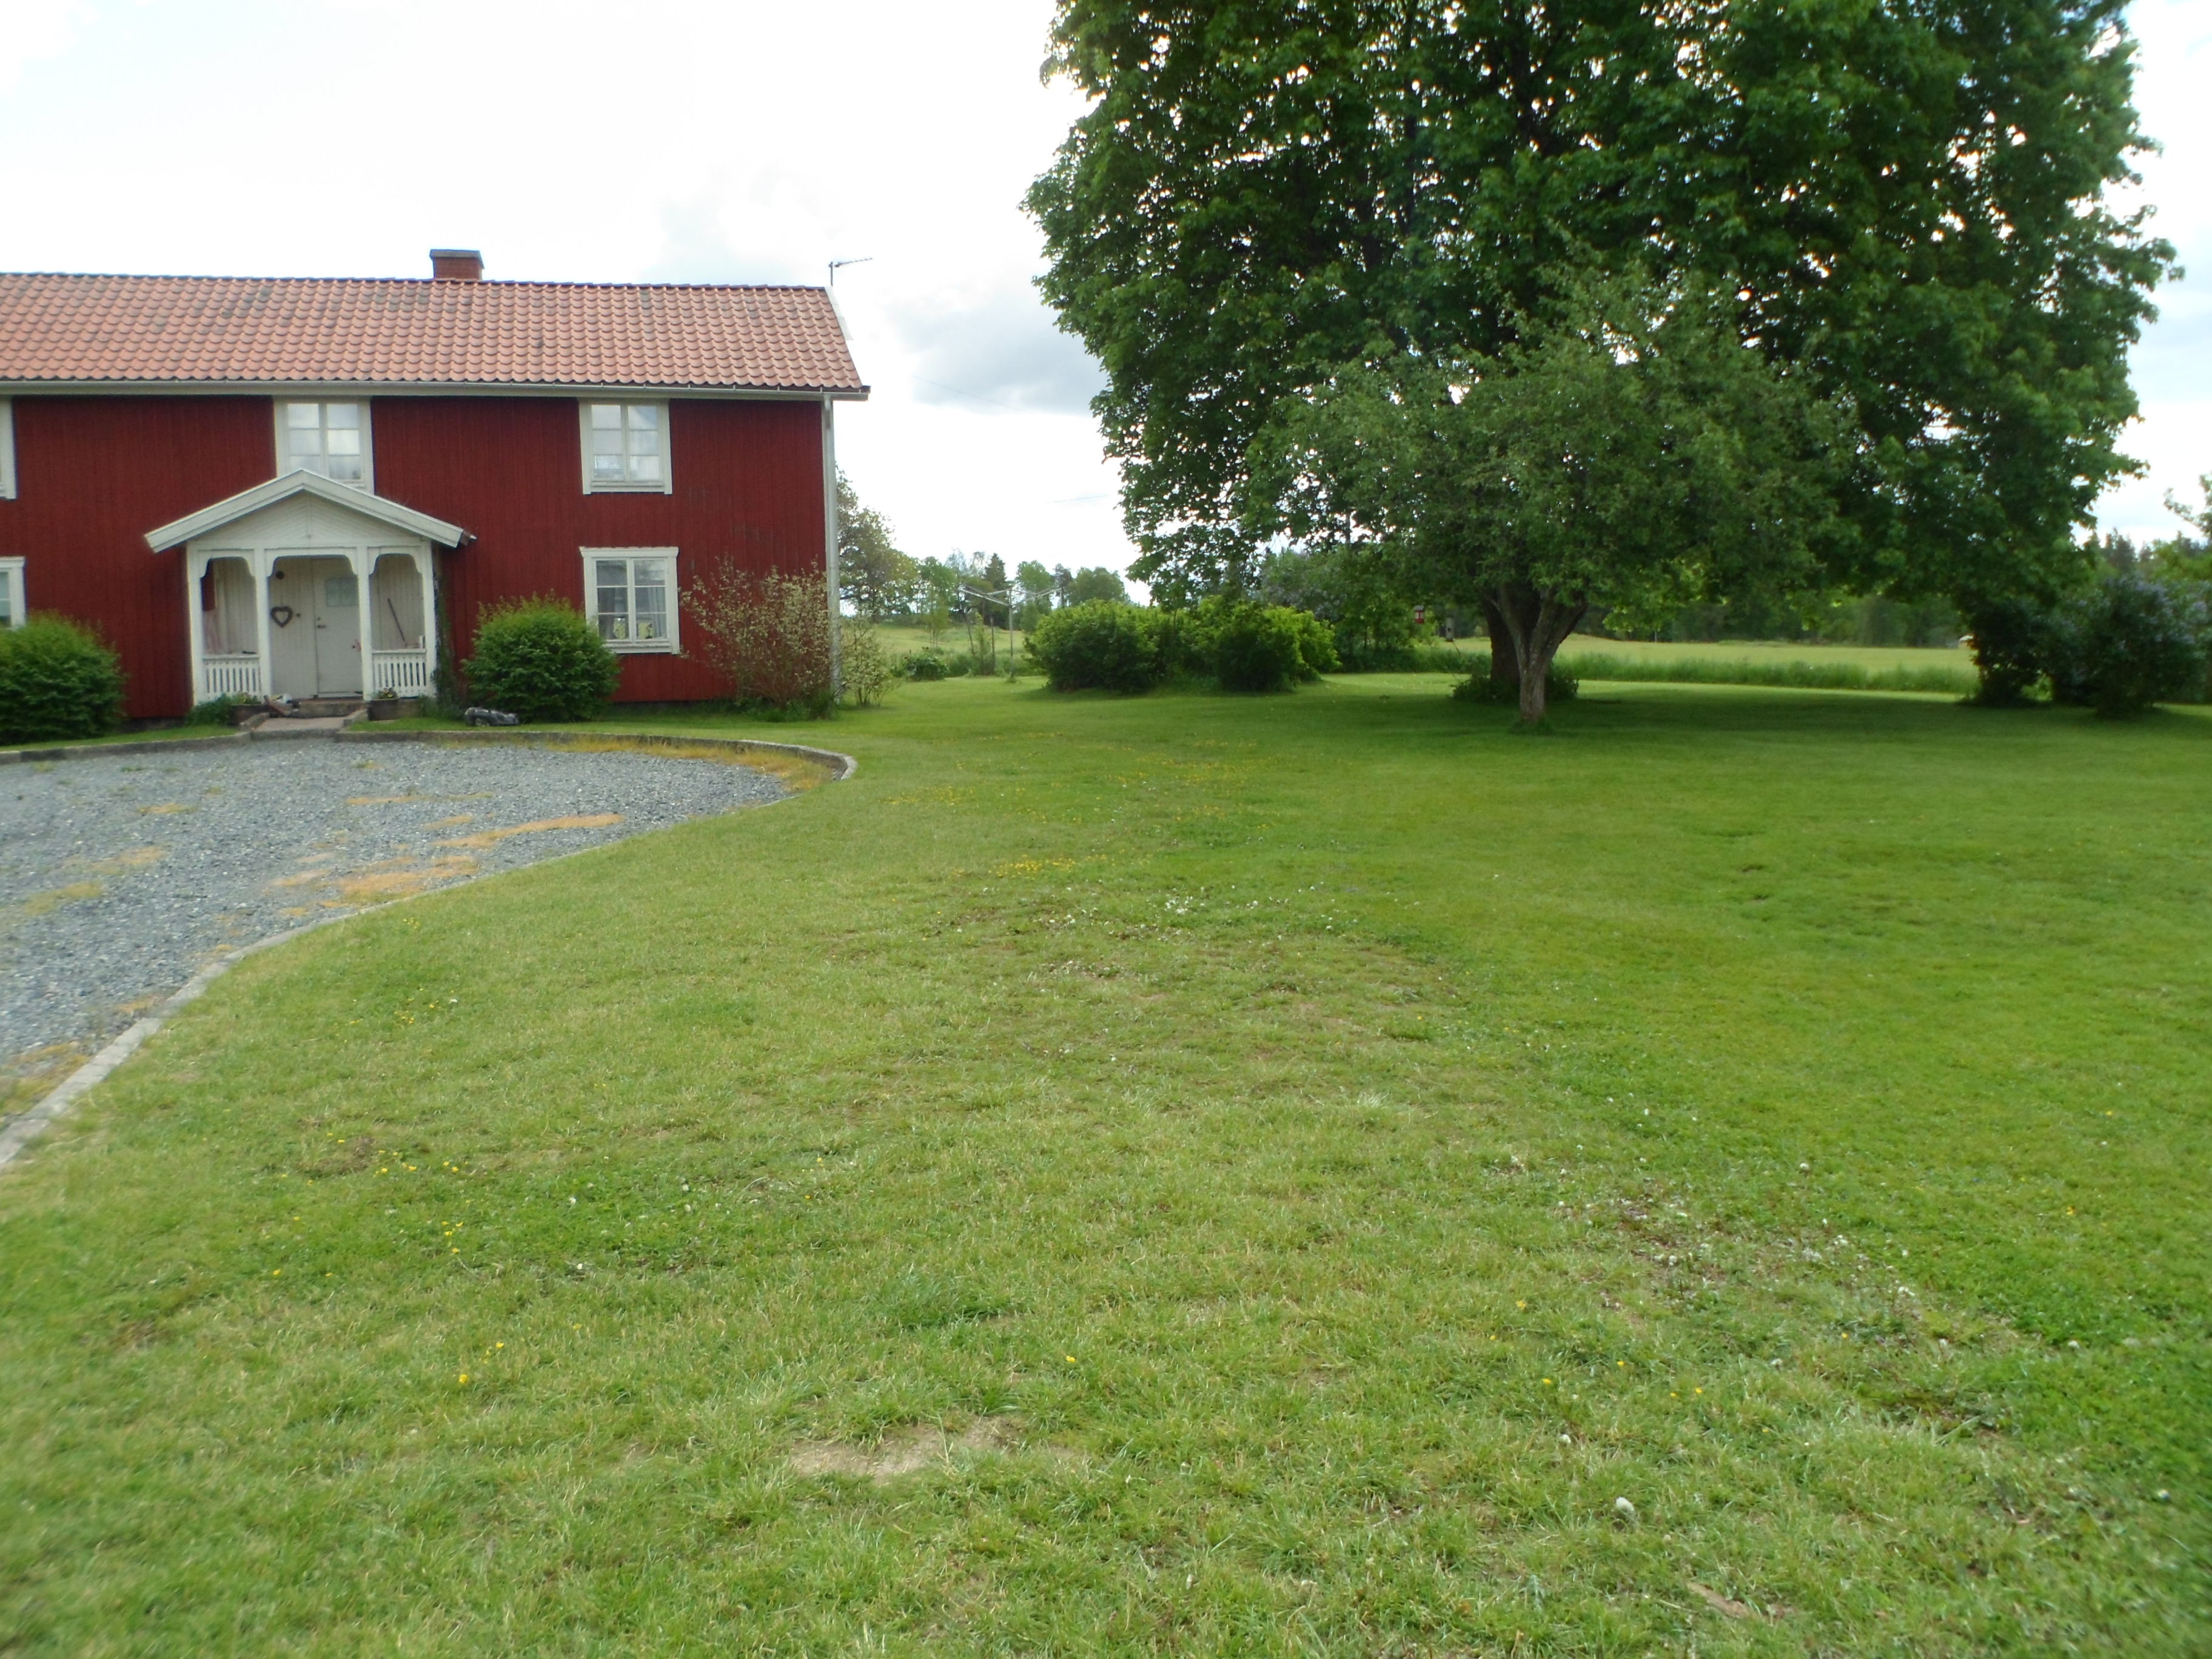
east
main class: Grassland
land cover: Grassland without tree/shrub cover
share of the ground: > 75 %
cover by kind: herbaceous plants 100 %
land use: Residential
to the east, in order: Grassland without tree/shrub cover; Artificial constructions in urban areas; Grassland without tree/shrub cover; Fences; Paved roads, cycling and walking lanes; Fences; Grassland without tree/shrub cover
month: June
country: SE
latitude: 57.4163
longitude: 14.1746
